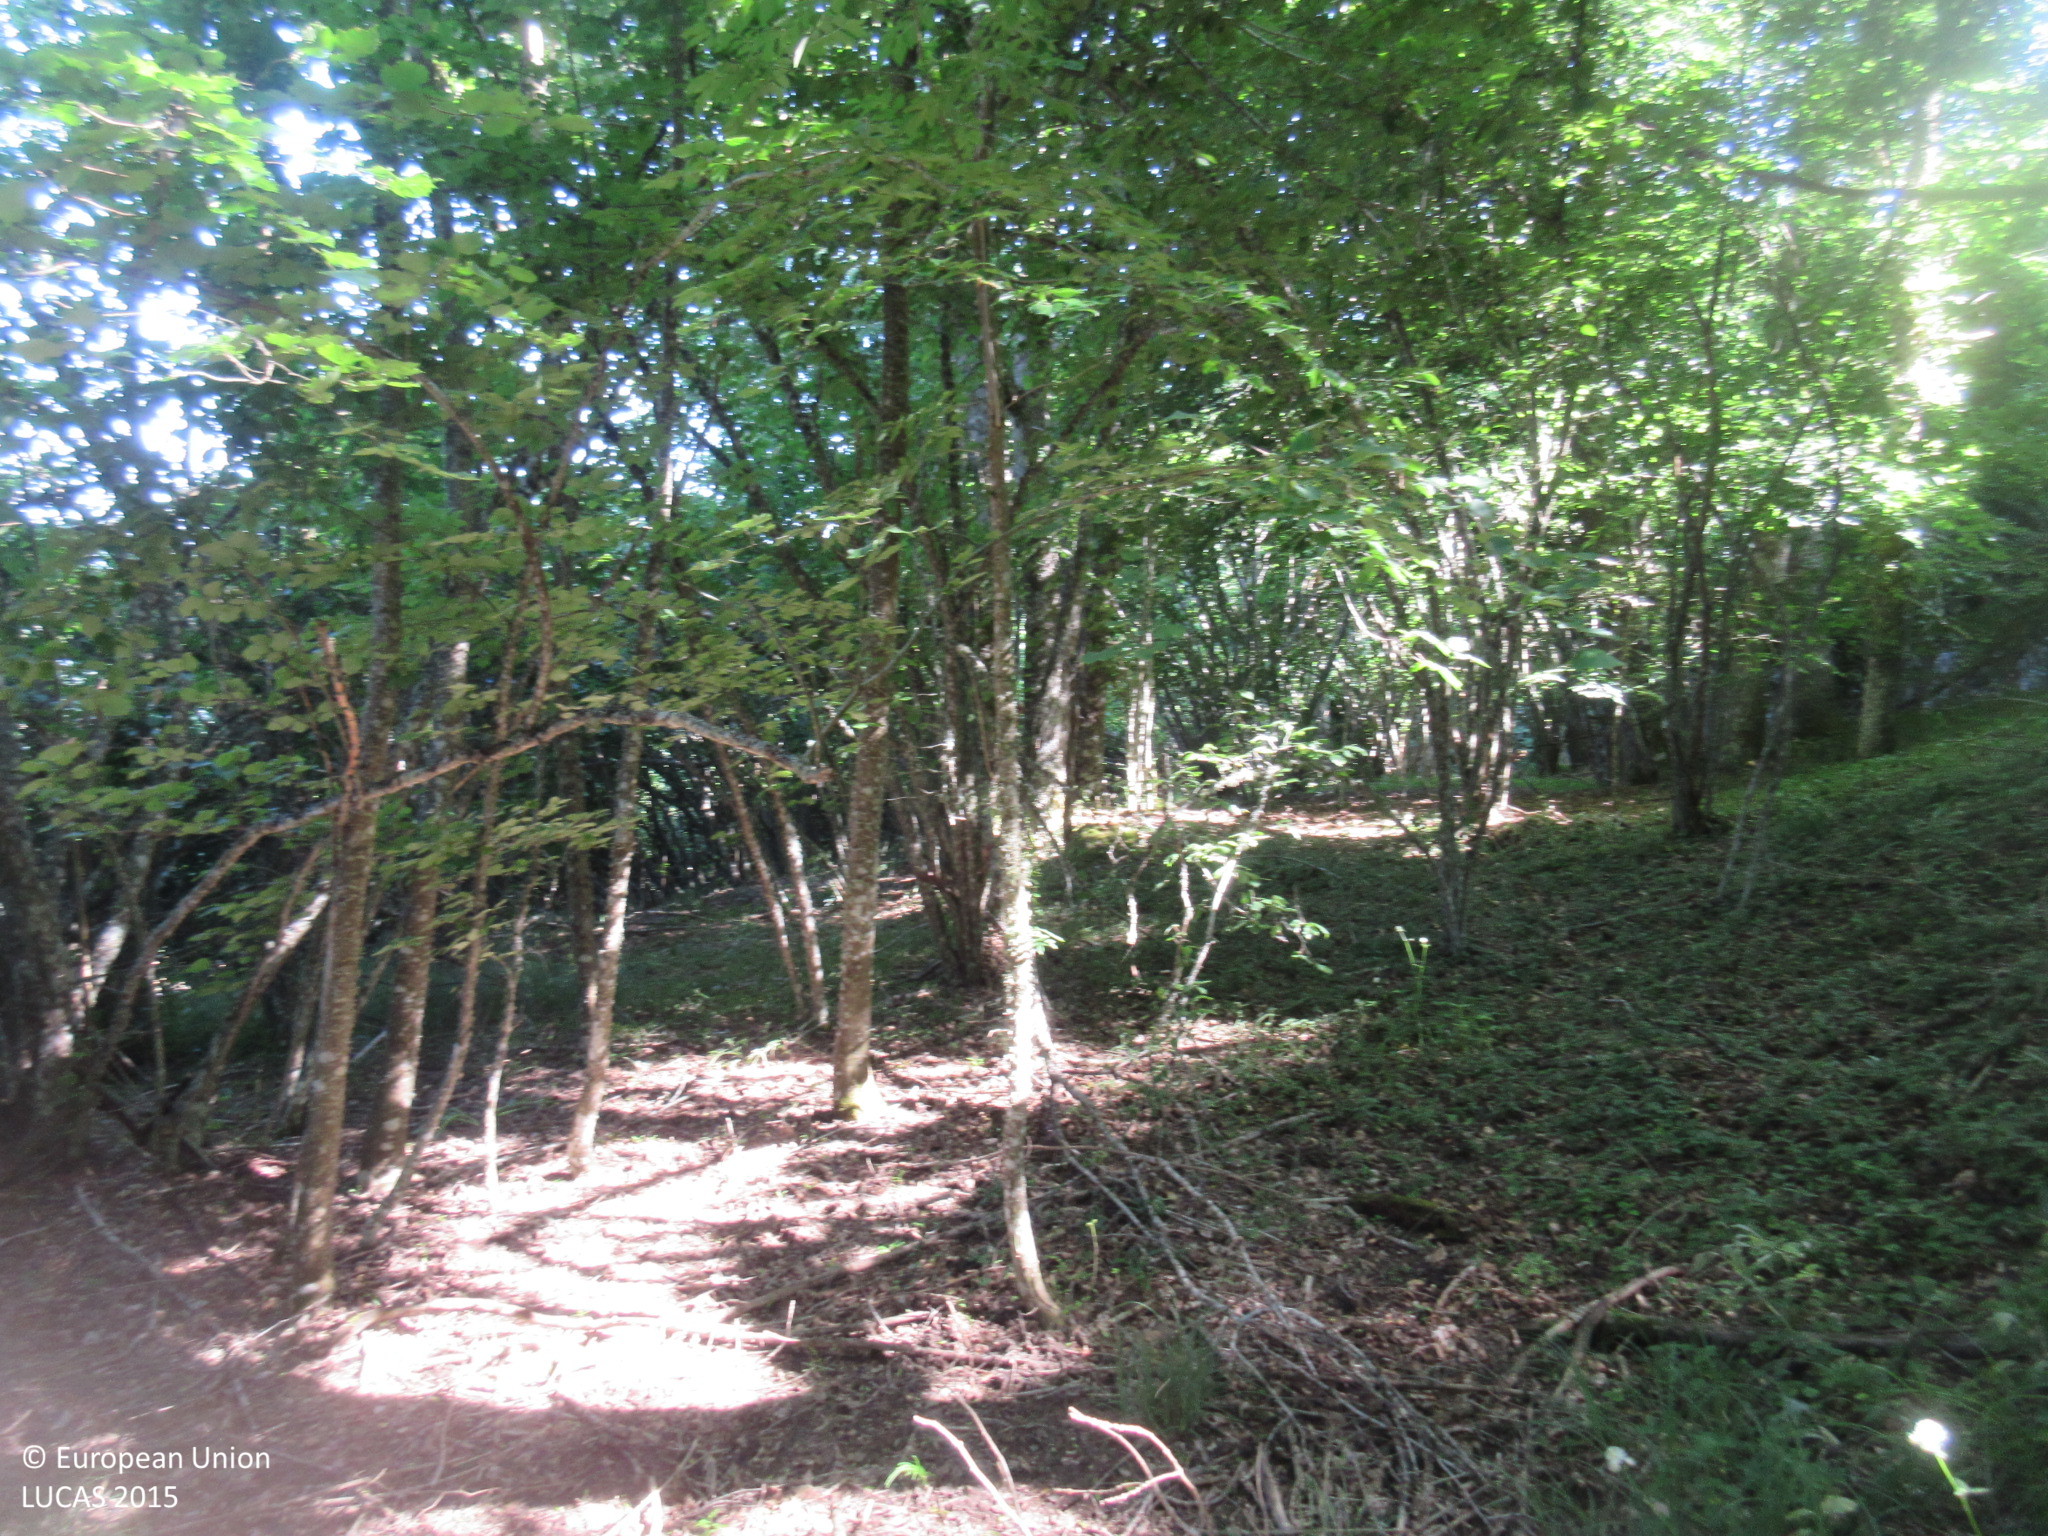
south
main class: Woodland
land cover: Broadleaved woodland
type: thermophilous deciduous forest
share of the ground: > 75 %
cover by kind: broadleaved forest trees 100 %
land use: Semi-natural and natural areas not in use
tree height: > 5 m
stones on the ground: < 10 %
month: July
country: ES
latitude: 42.9260
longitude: -3.8278
